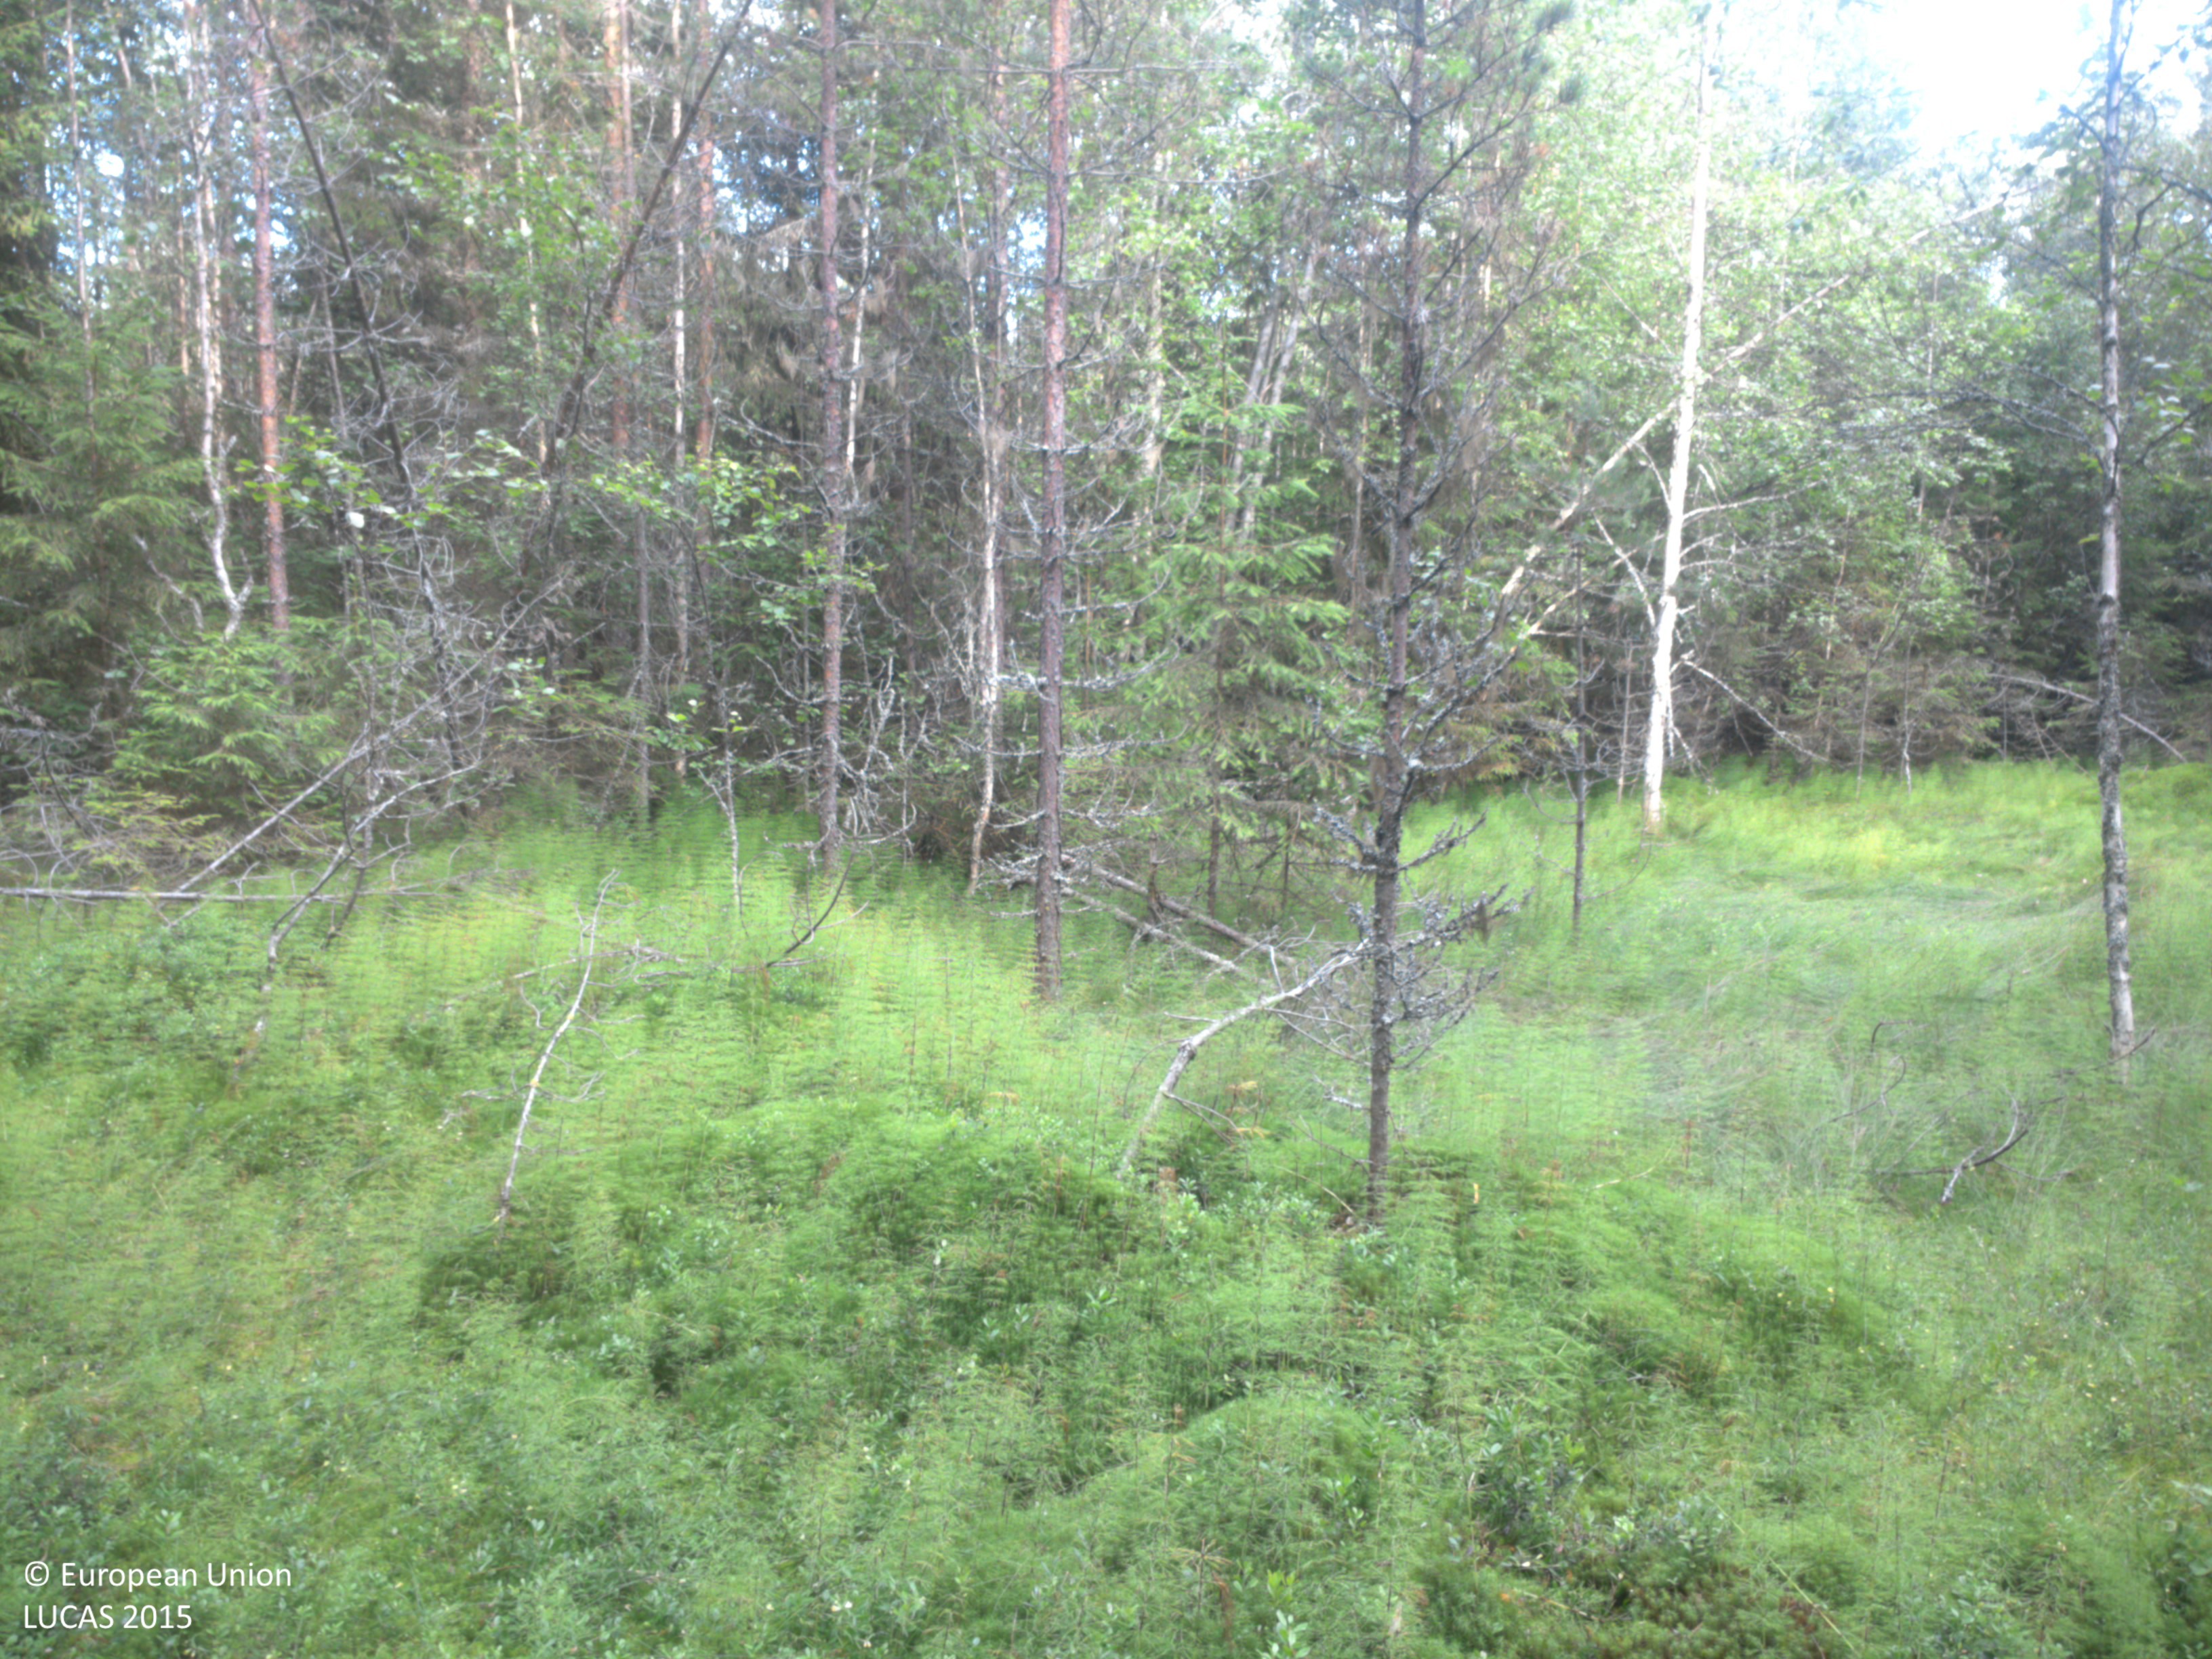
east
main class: Woodland
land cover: Other mixed woodland
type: boreal forest
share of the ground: 50 - 75 %
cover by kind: coniferous forest trees 40 %, broadleaved forest trees 20 %, shrubs 20 %, herbaceous plants 20 %
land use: Forestry
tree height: > 5 m
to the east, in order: Other mixed woodland; Peatbogs; Other mixed woodland; Ditches and canals; Other mixed woodland; Peatbogs; Other mixed woodland; Ditches and canals; Other mixed woodland; Ditches and canals; Grass margins; Paved roads, cycling and walking lanes; Grass margins; Ditches and canals; Other mixed woodland; Broadleaved woodland; Other mixed woodland; Ditches and canals; Other mixed woodland; Peatbogs; Other mixed woodland
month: July
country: SE
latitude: 63.4822
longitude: 19.3950
